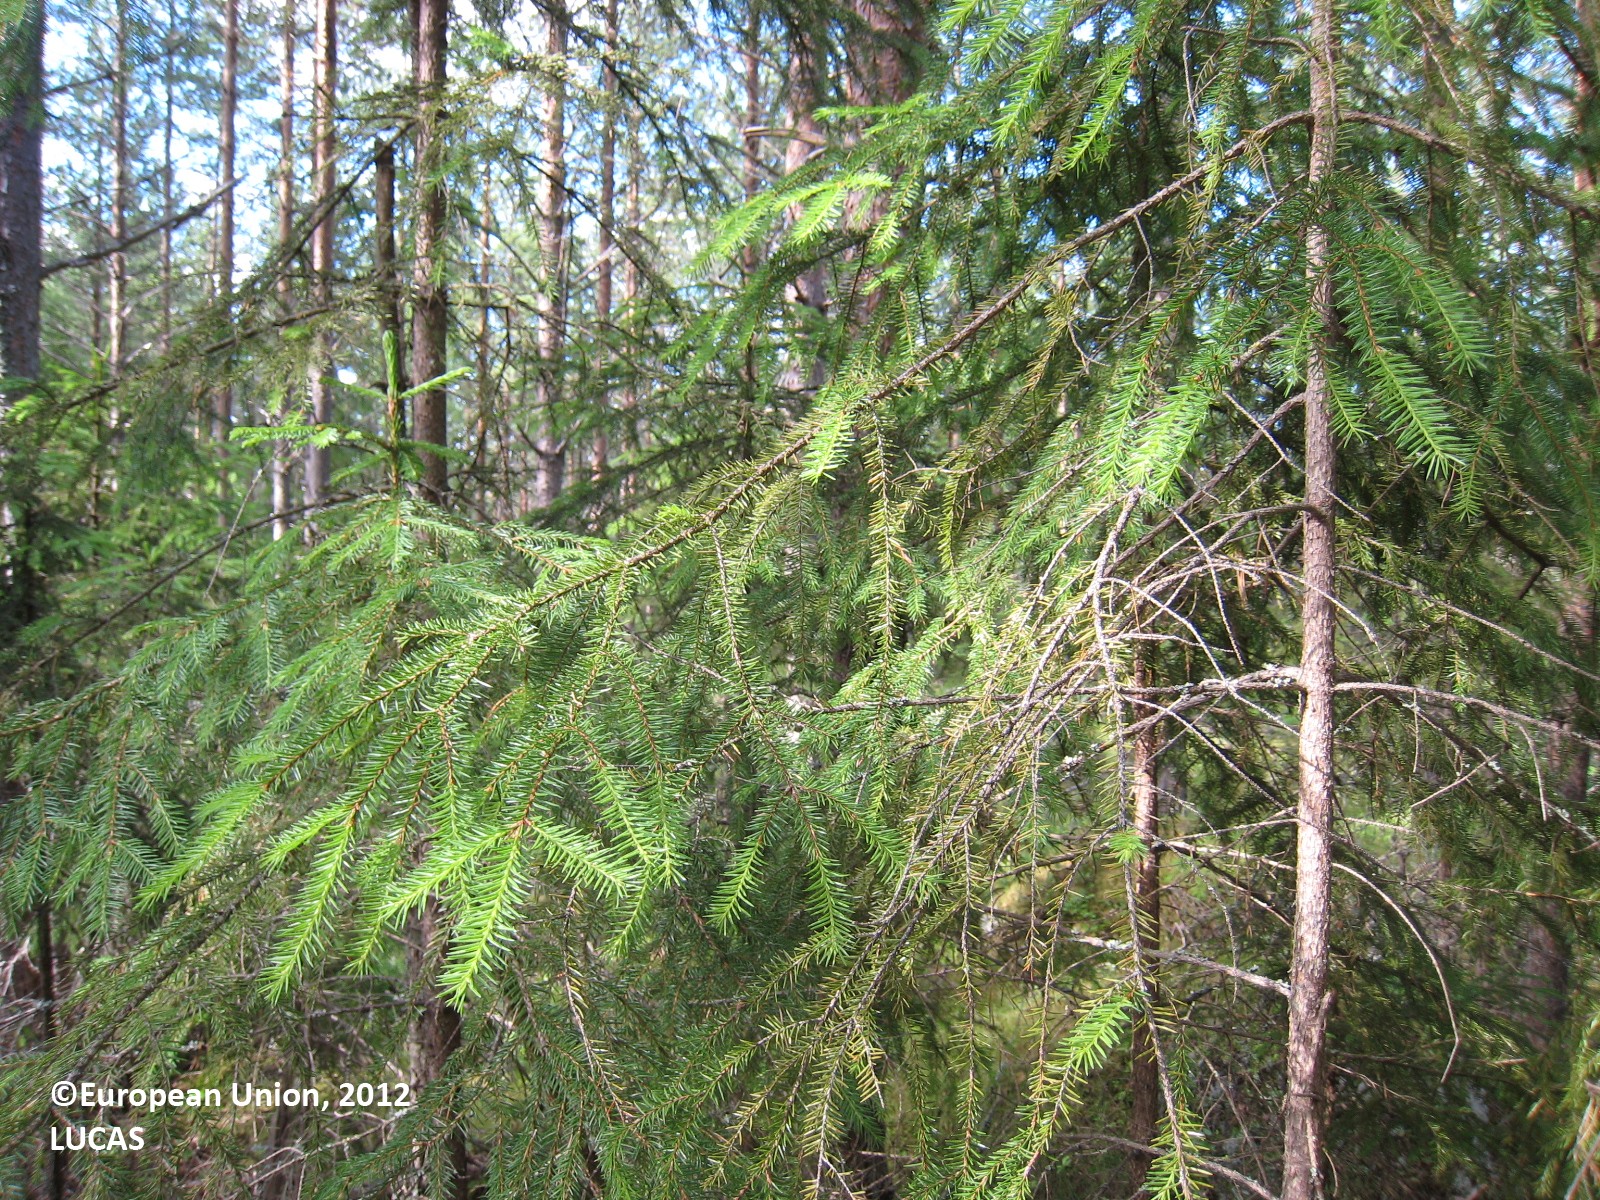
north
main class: Woodland
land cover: Other coniferous woodland
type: boreal forest
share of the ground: 50 - 75 %
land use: Forestry
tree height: > 5 m
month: July
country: FI
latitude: 62.7786
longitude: 25.6920
